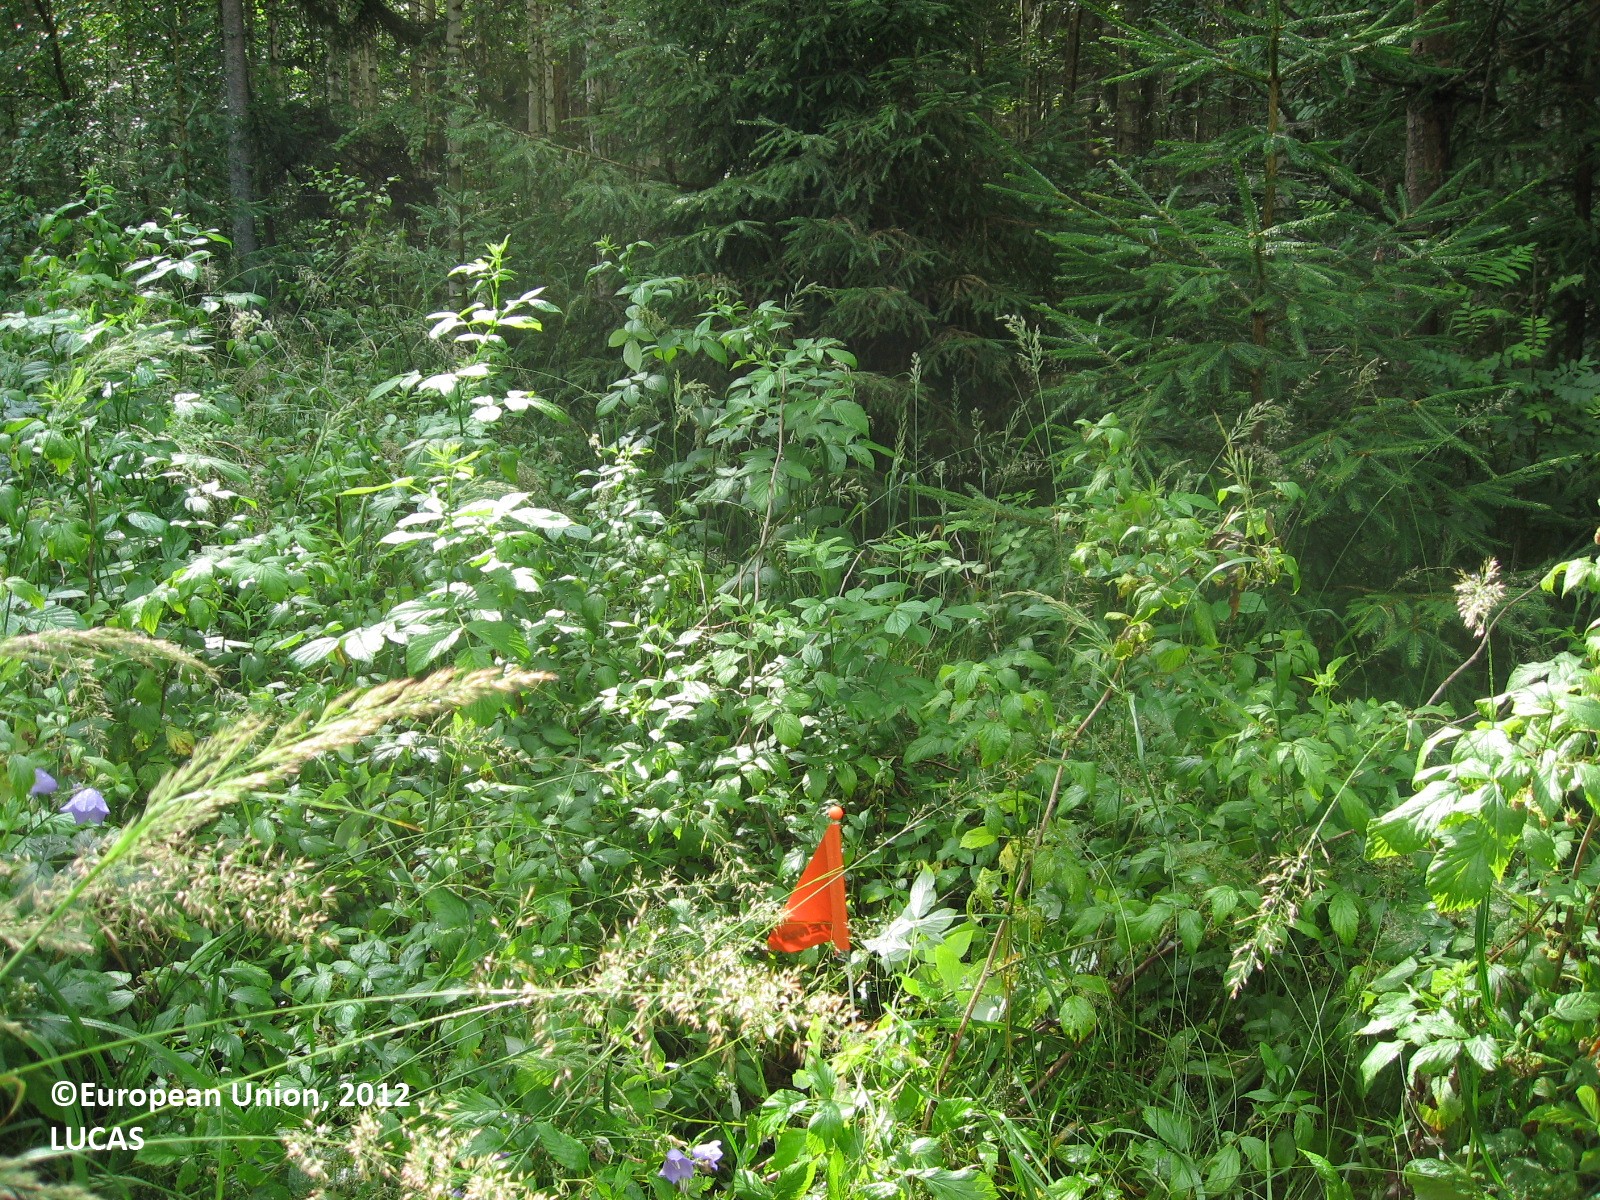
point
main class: Shrubland
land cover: Shrubland with sparse tree cover
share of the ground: > 75 %
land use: Forestry
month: July
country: FI
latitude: 61.2796
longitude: 25.8965
